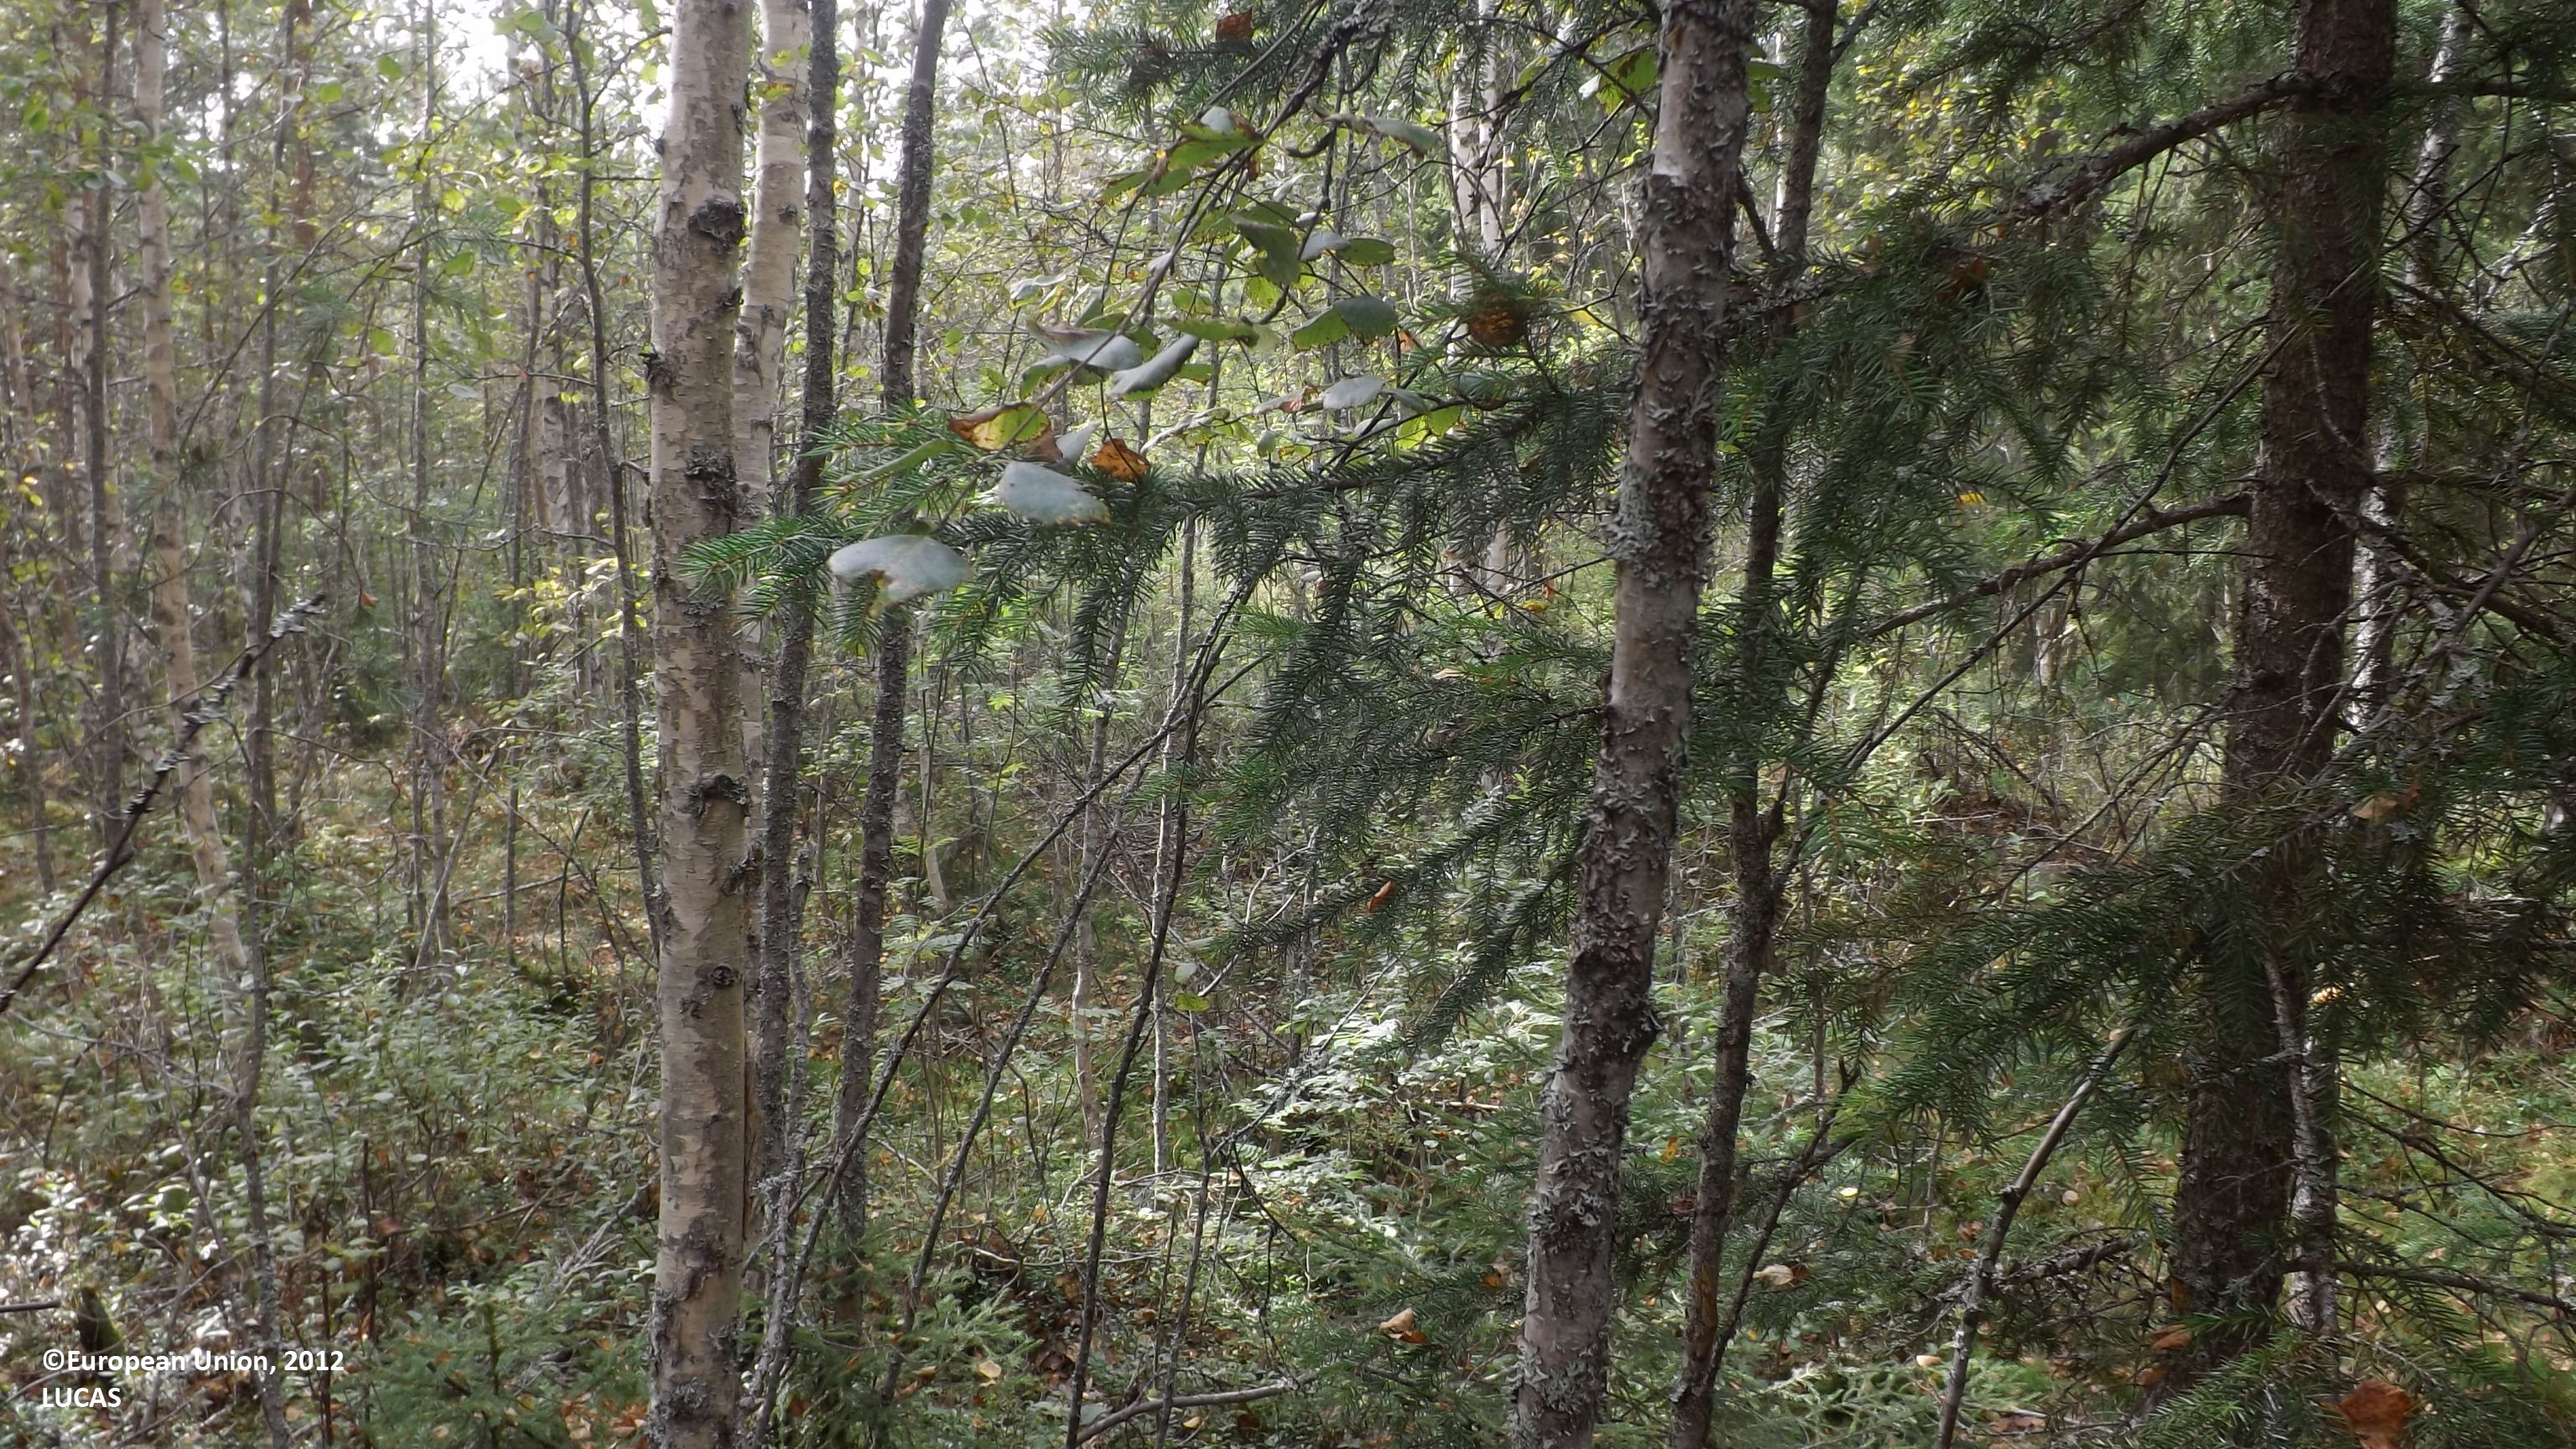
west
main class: Woodland
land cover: Other mixed woodland
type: boreal forest
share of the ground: > 75 %
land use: Forestry
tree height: > 5 m
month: August
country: FI
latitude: 63.9179
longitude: 24.0313
